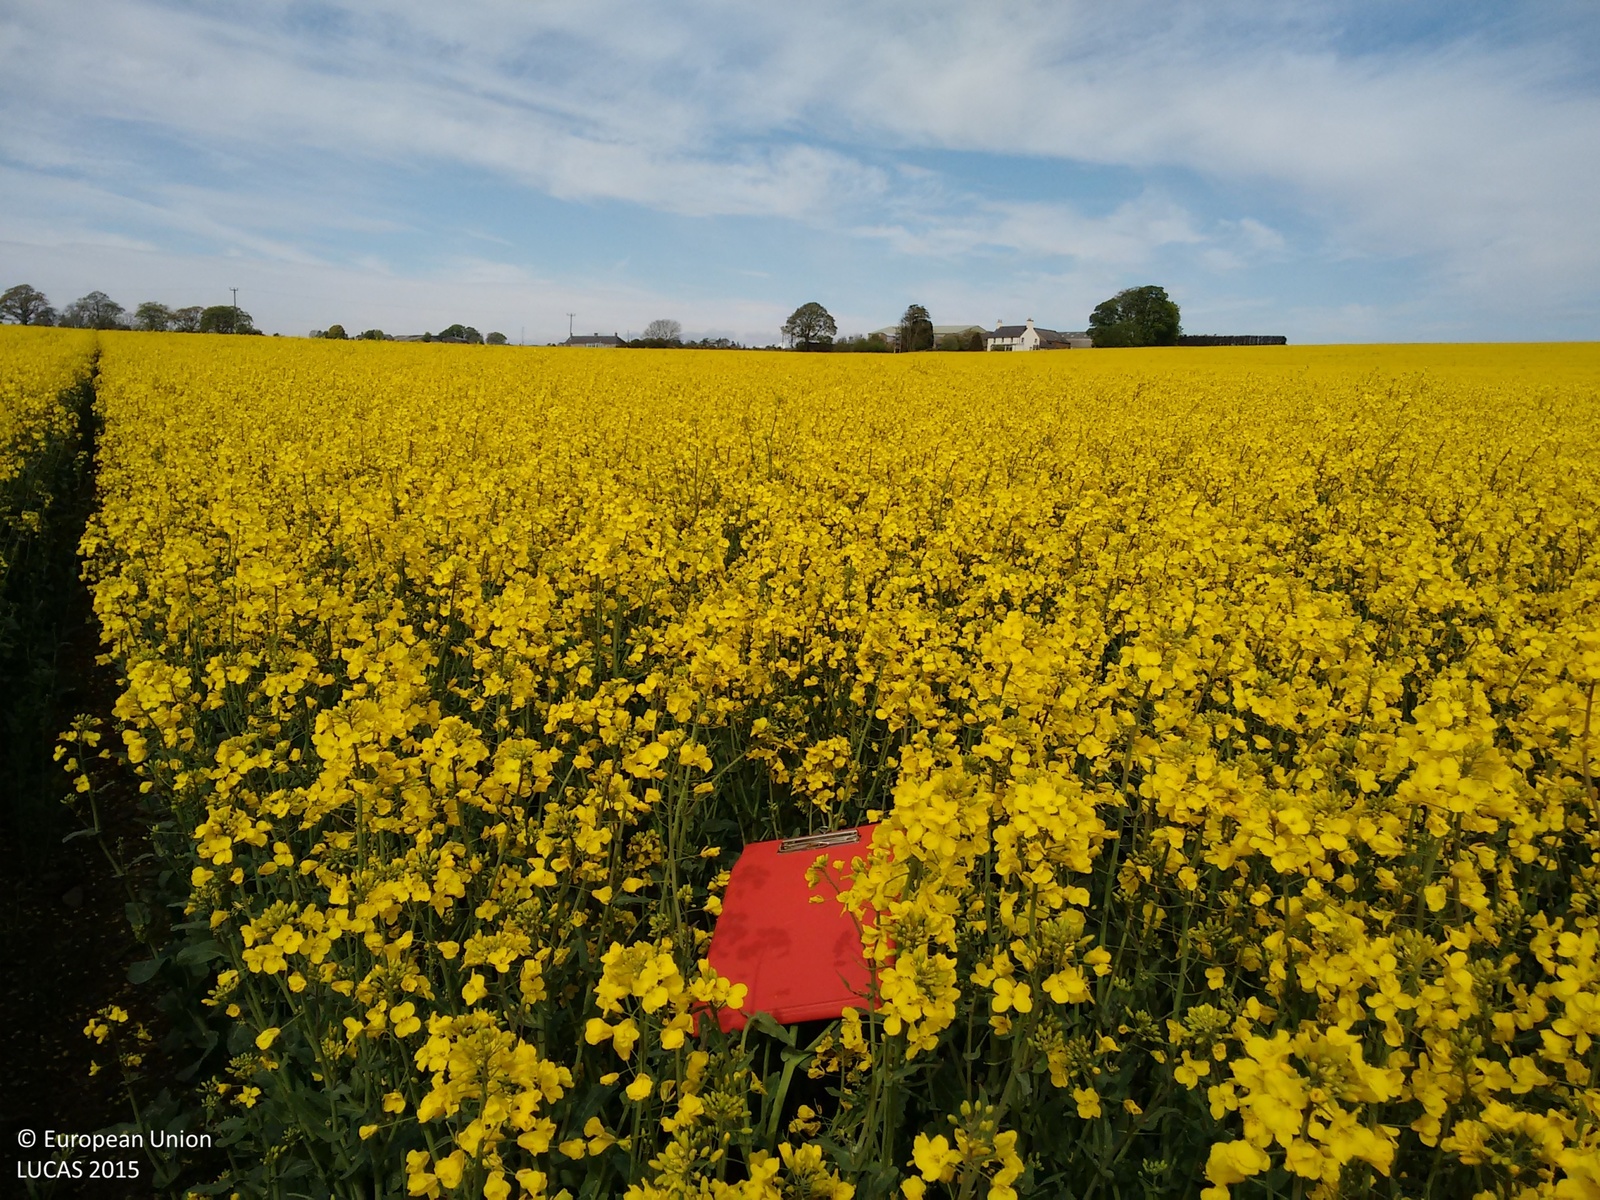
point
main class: Cropland
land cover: Rape and turnip rape
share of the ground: > 75 %
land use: Agriculture (excluding fallow land and kitchen gardens)
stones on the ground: 10 - 25 %
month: May
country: GB
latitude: 56.7066
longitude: -2.6527
